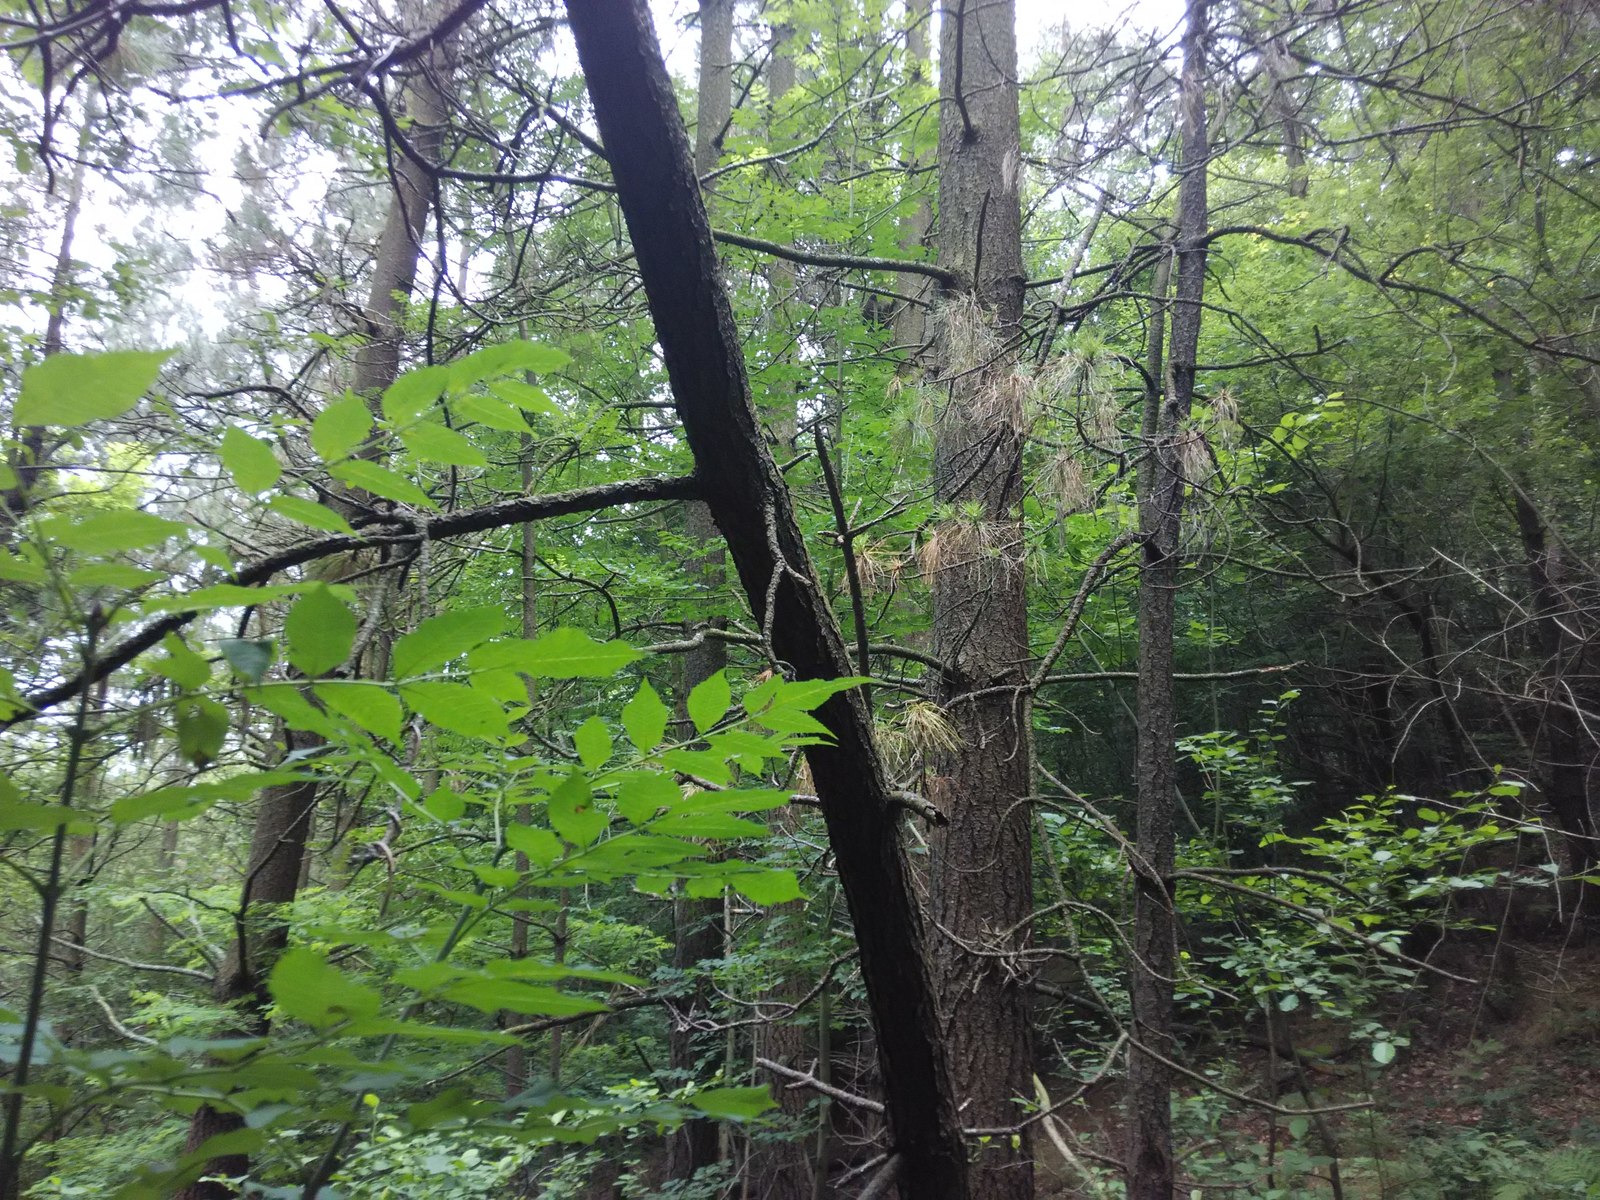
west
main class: Woodland
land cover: Pine dominated mixed woodland
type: exotic forest
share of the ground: 50 - 75 %
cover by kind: coniferous forest trees 60 %, broadleaved forest trees 40 %
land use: Forestry
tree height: > 5 m
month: July
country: ES
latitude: 43.1170
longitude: -2.5015
